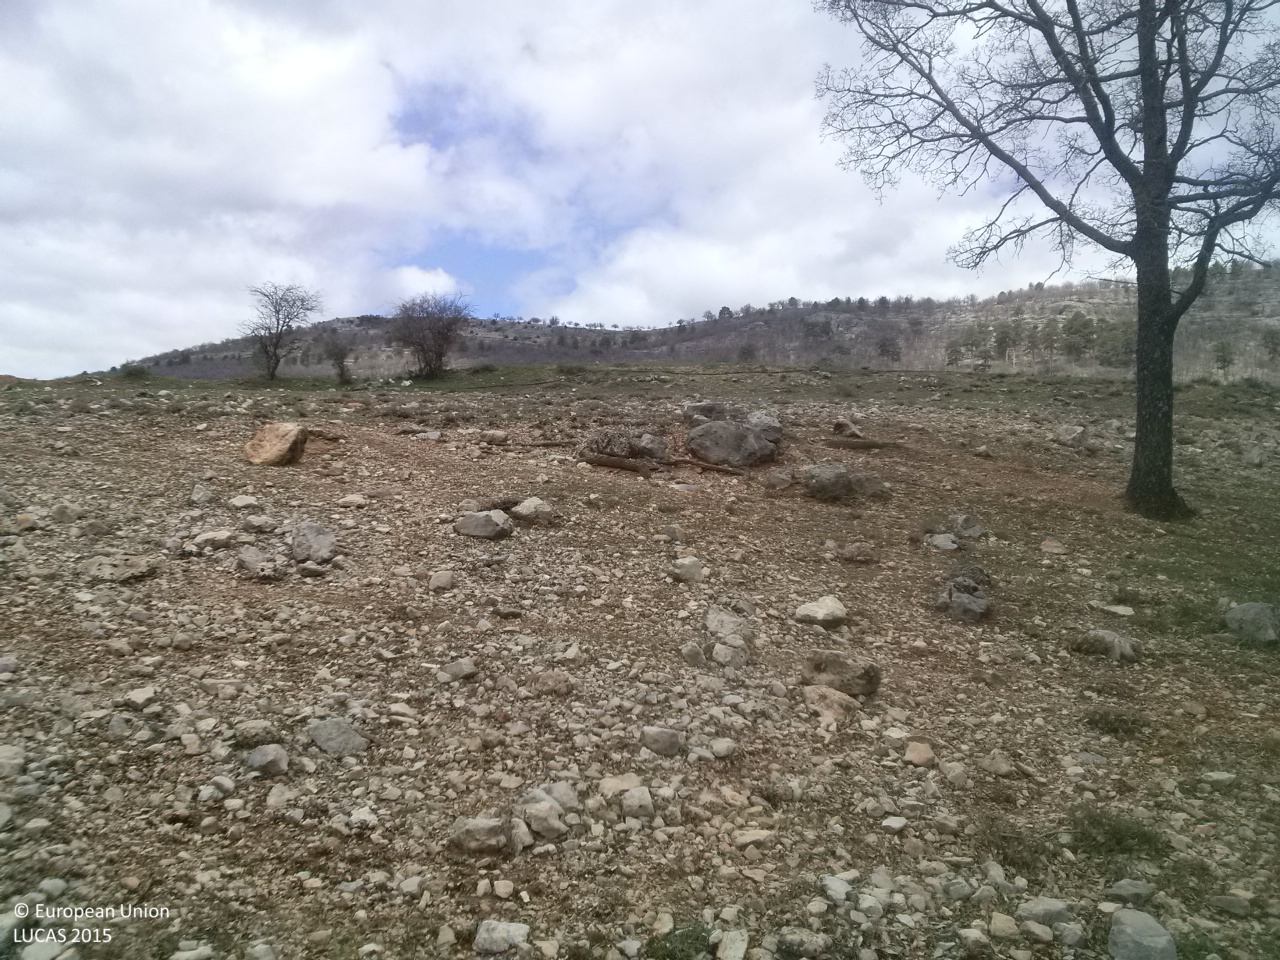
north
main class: Grassland
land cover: Grassland with sparse tree/shrub cover
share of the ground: 50 - 75 %
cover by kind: herbaceous plants 65 %, unconsolidated bare surface 30 %, broadleaved forest trees 5 %
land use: Agriculture (excluding fallow land and kitchen gardens)
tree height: > 5 m
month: April
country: ES
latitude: 40.3352
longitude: -1.8224
